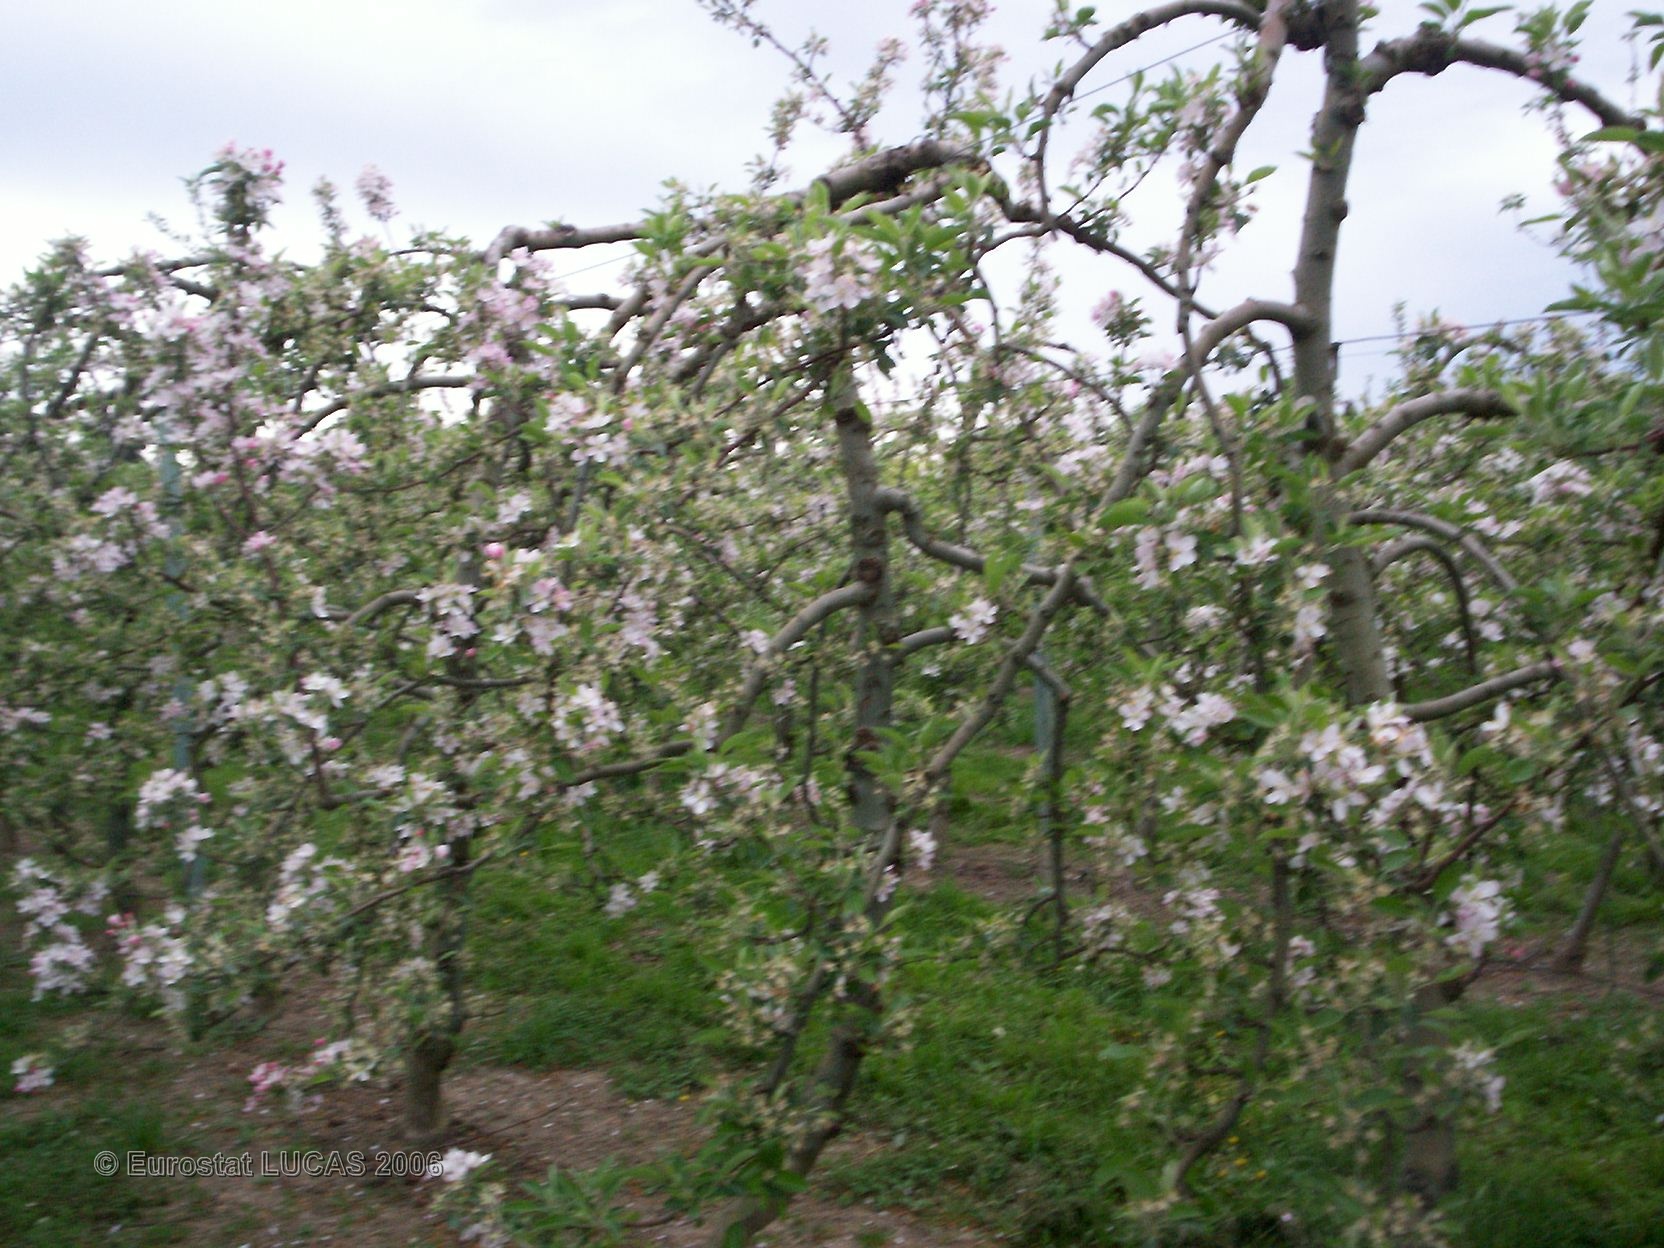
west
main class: Cropland
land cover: Apple fruit
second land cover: Grassland with sparse tree/shrub cover
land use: Agriculture (excluding fallow land and kitchen gardens)
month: April
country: FR
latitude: 43.8647
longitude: 4.9198
